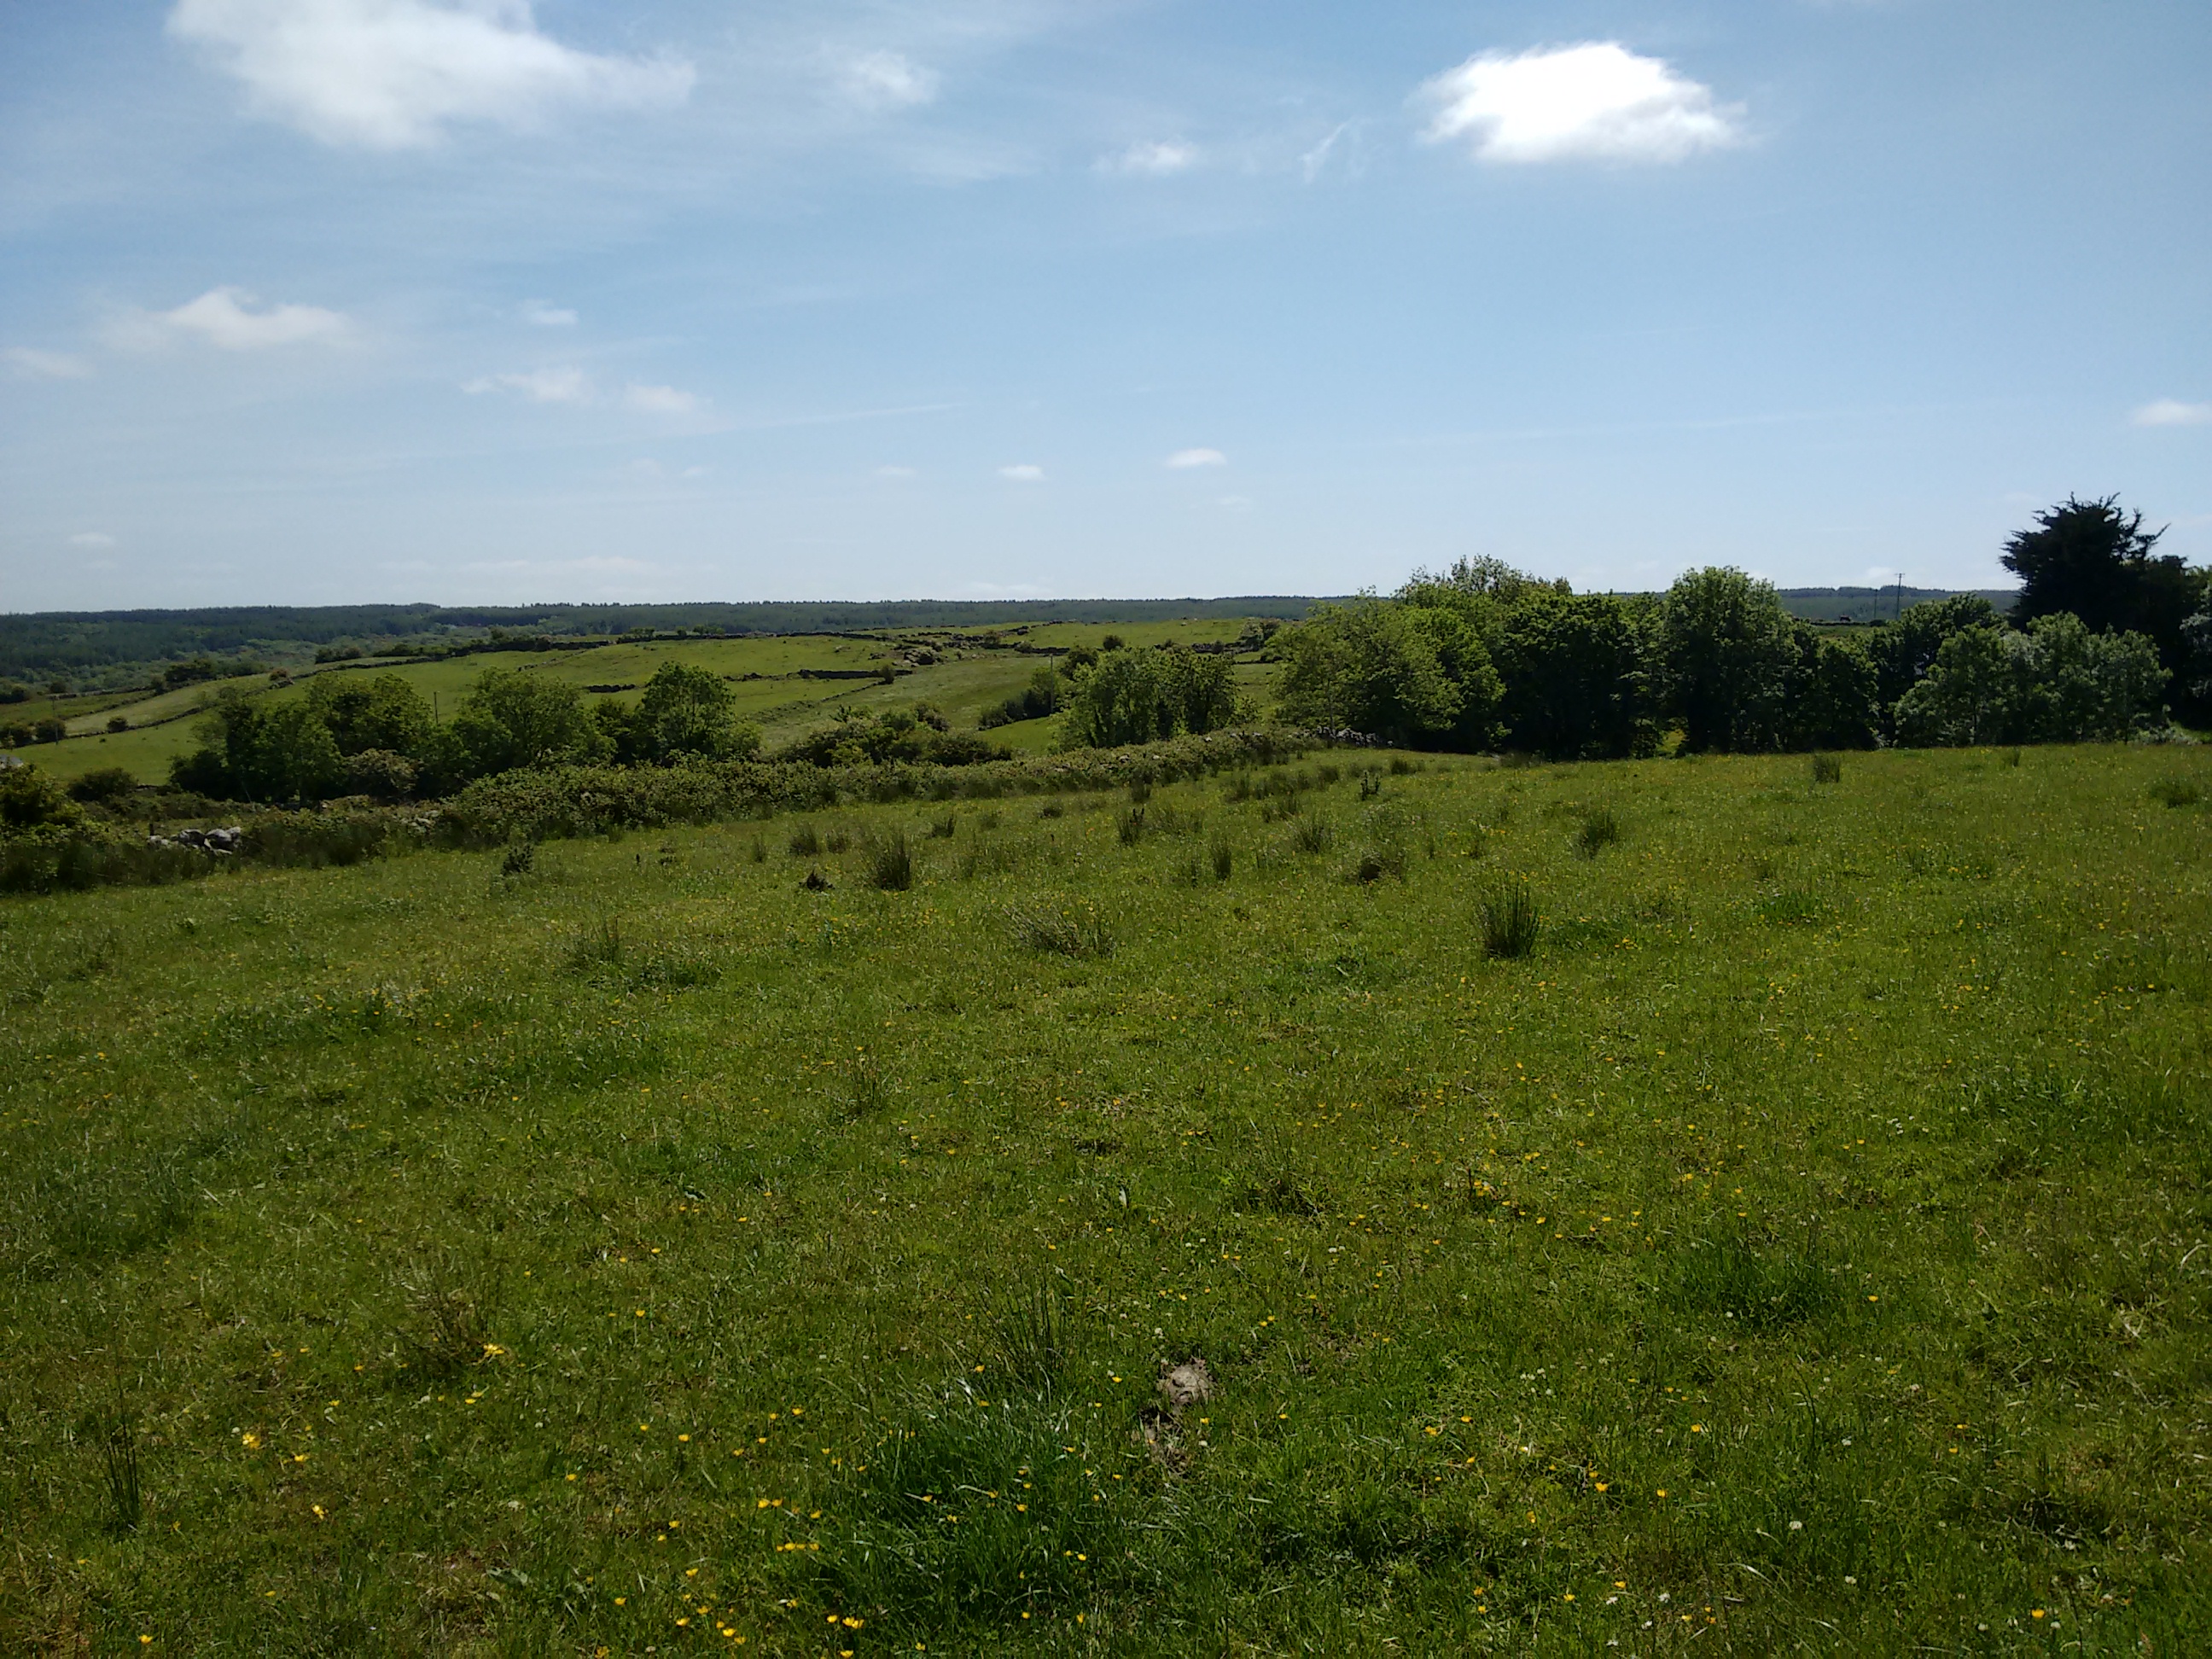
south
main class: Grassland
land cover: Grassland without tree/shrub cover
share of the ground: > 75 %
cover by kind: herbaceous plants 100 %
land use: Agriculture (excluding fallow land and kitchen gardens)
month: June
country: IE
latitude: 53.1521
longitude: -8.5428
